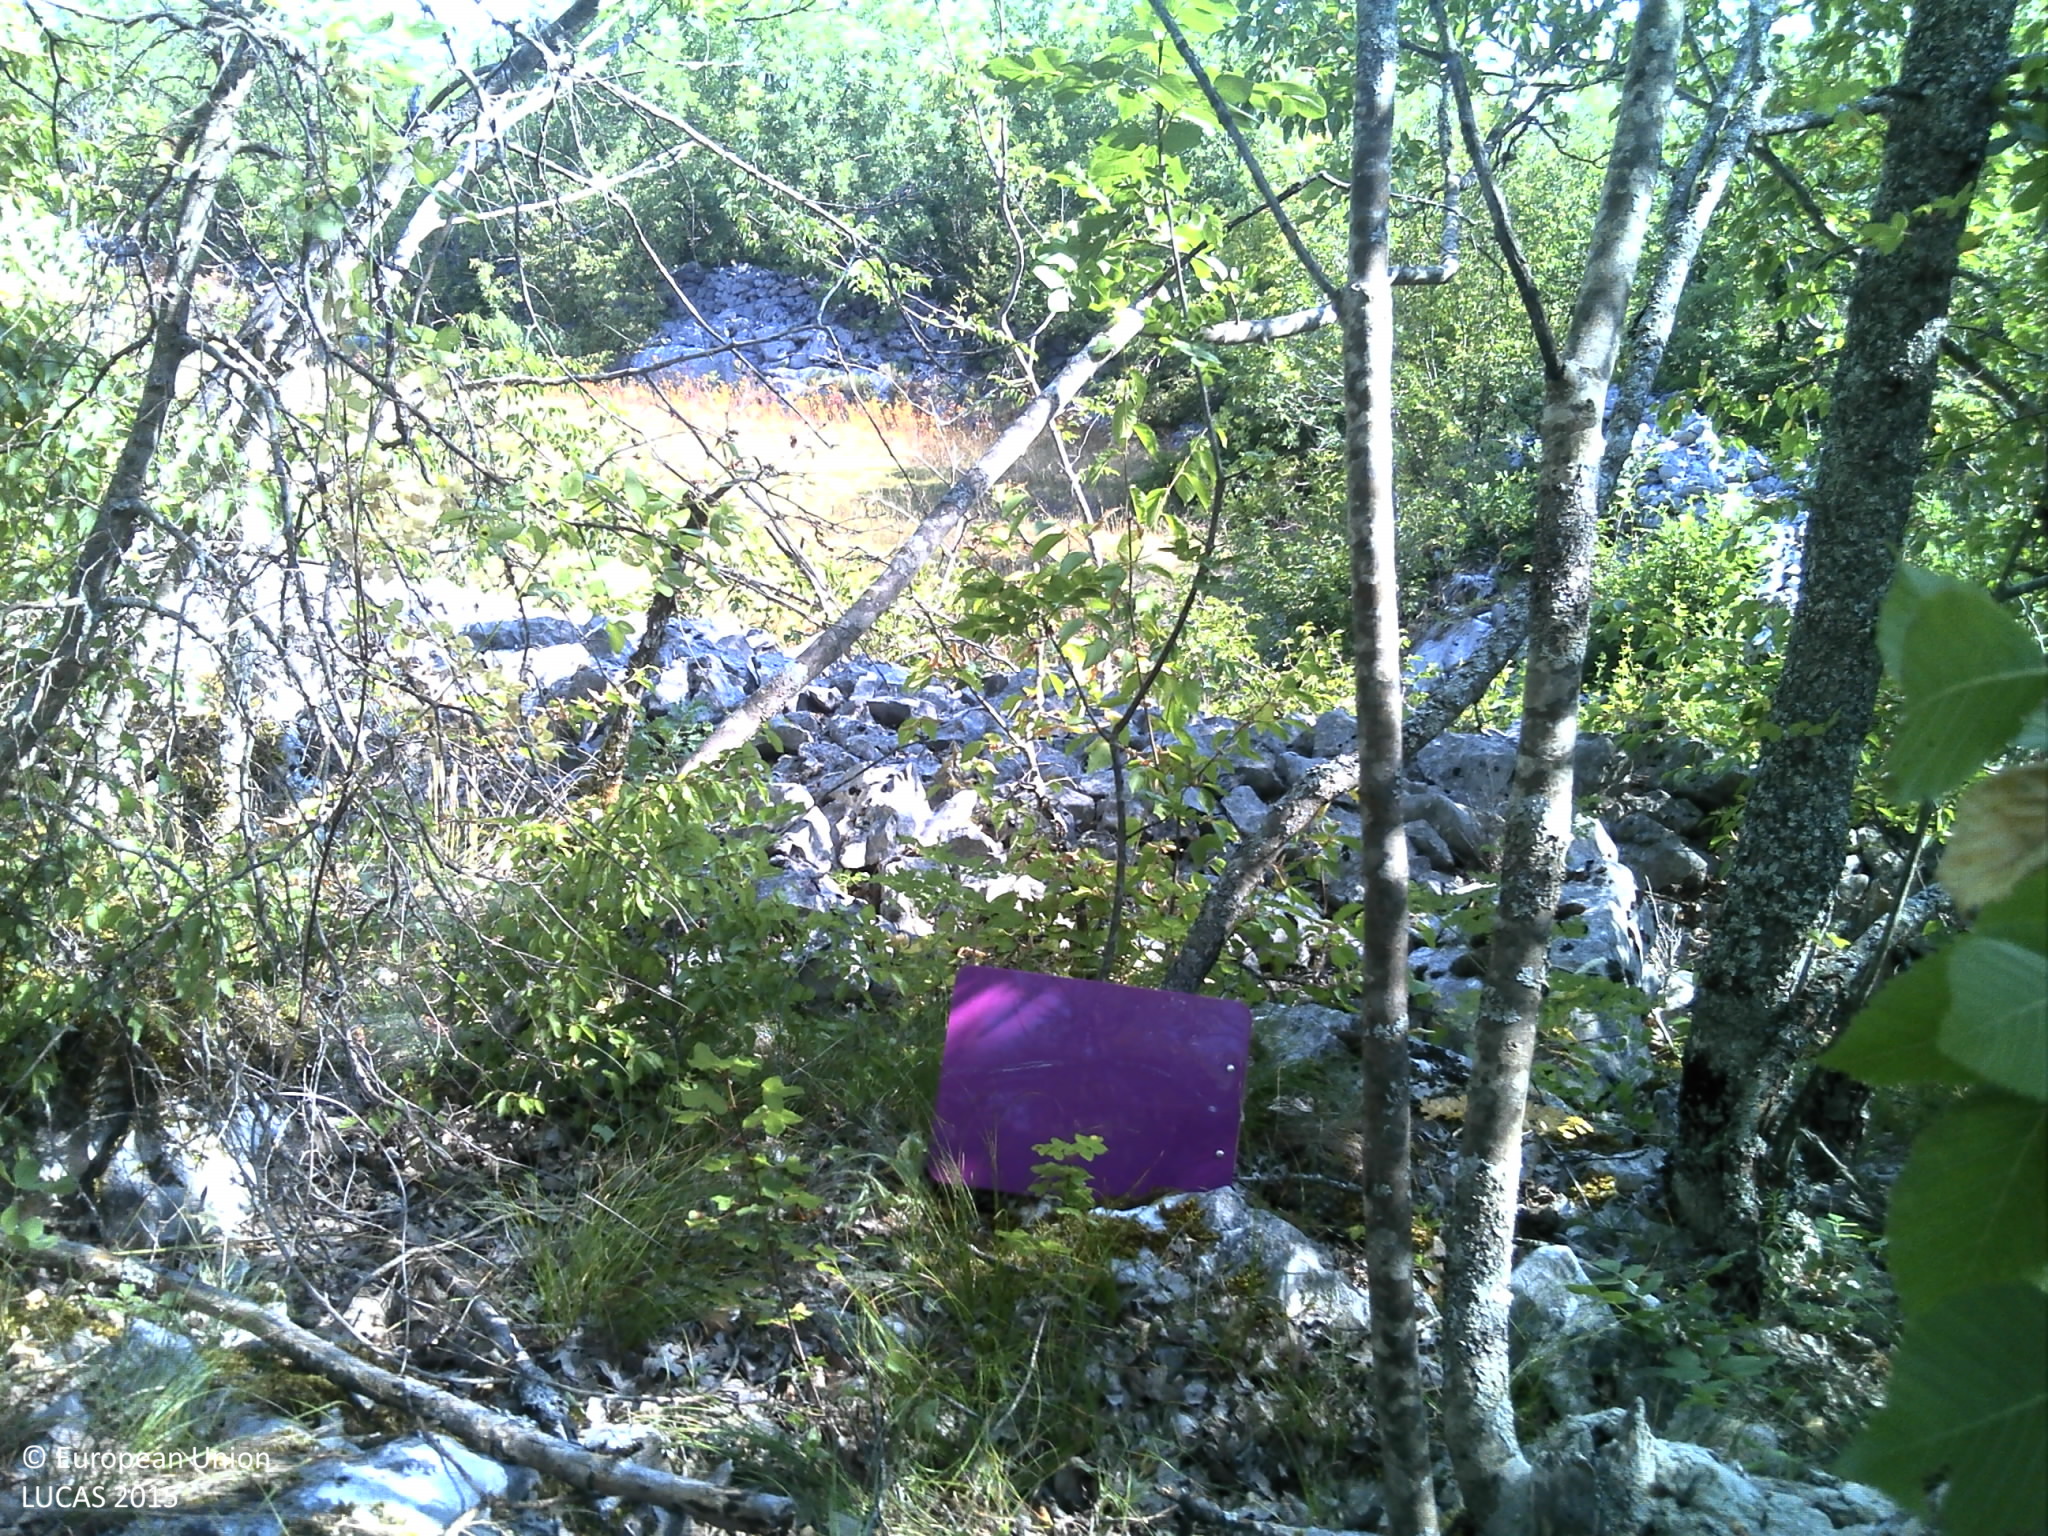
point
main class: Woodland
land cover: Broadleaved woodland
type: thermophilous deciduous forest
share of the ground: 50 - 75 %
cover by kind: broadleaved forest trees 65 %, shrubs 15 %, herbaceous plants 15 %, consolidated bare surface 5 %
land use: Semi-natural and natural areas not in use
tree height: > 5 m
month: July
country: HR
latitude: 43.4017
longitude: 17.0912
